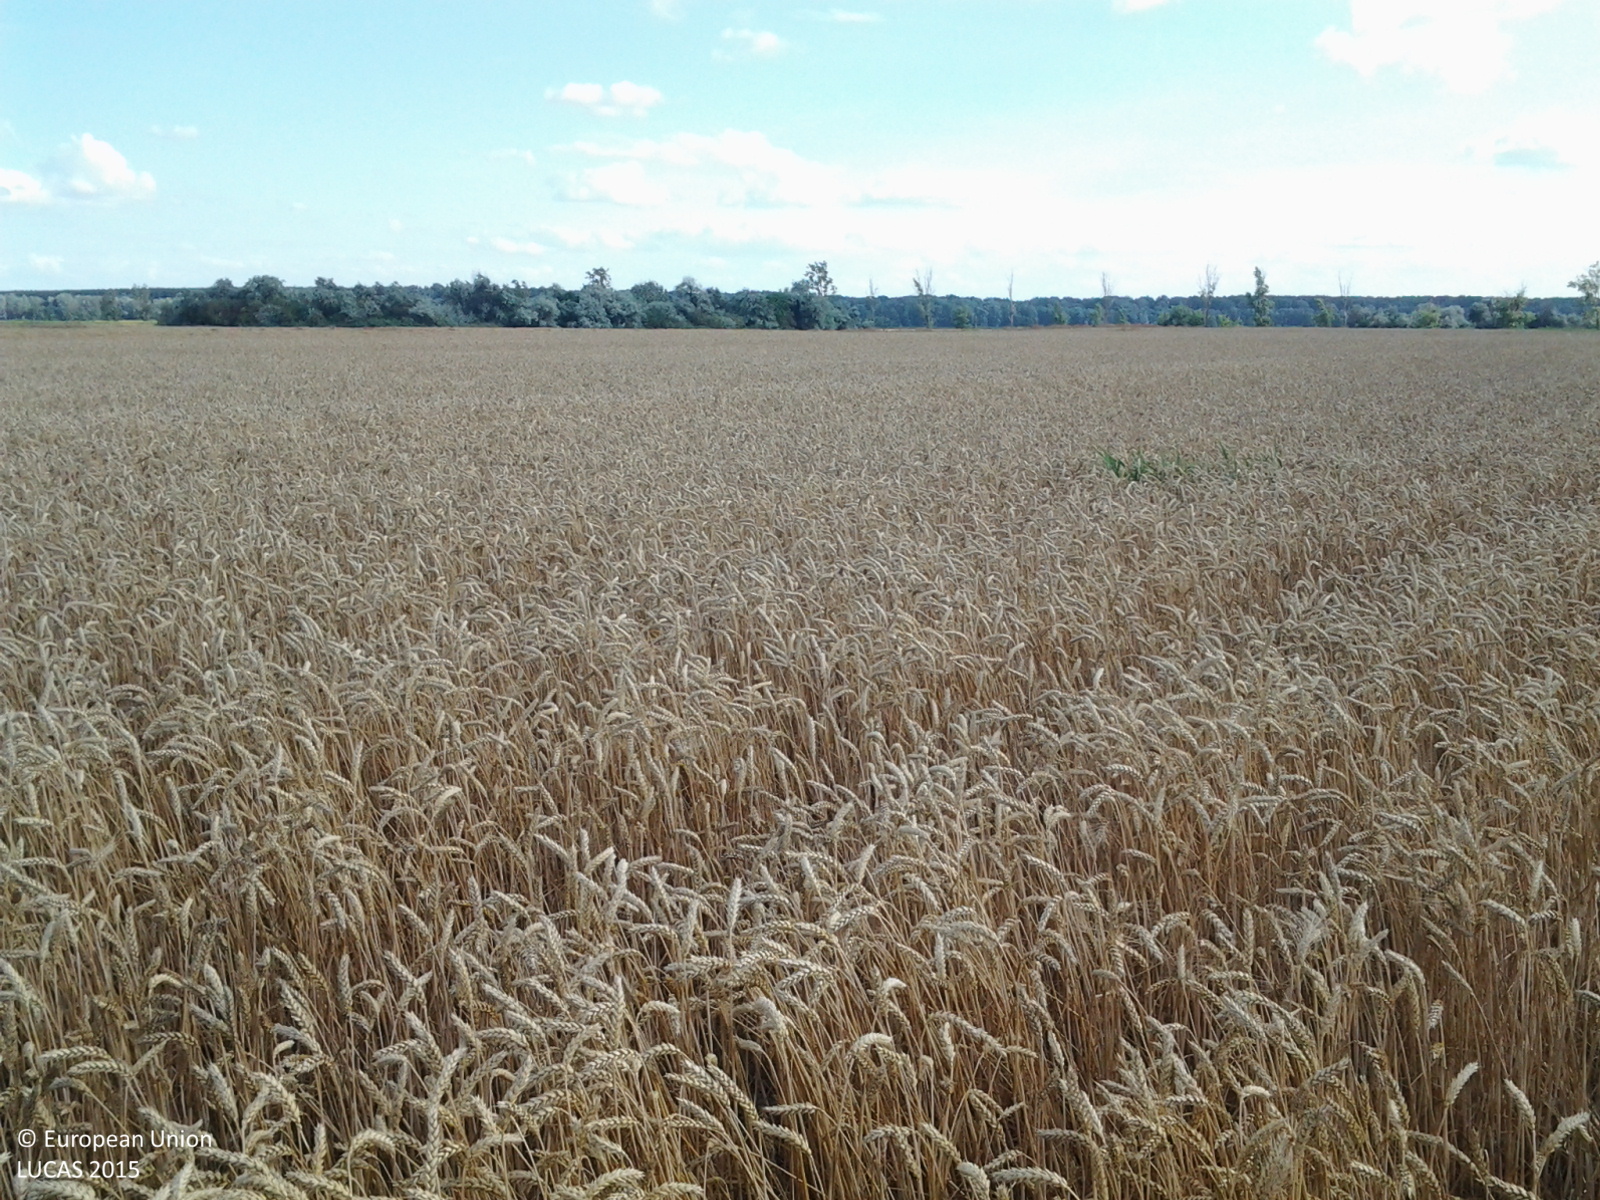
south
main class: Cropland
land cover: Common wheat
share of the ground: > 75 %
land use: Agriculture (excluding fallow land and kitchen gardens)
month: July
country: HU
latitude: 47.2761
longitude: 20.4062
